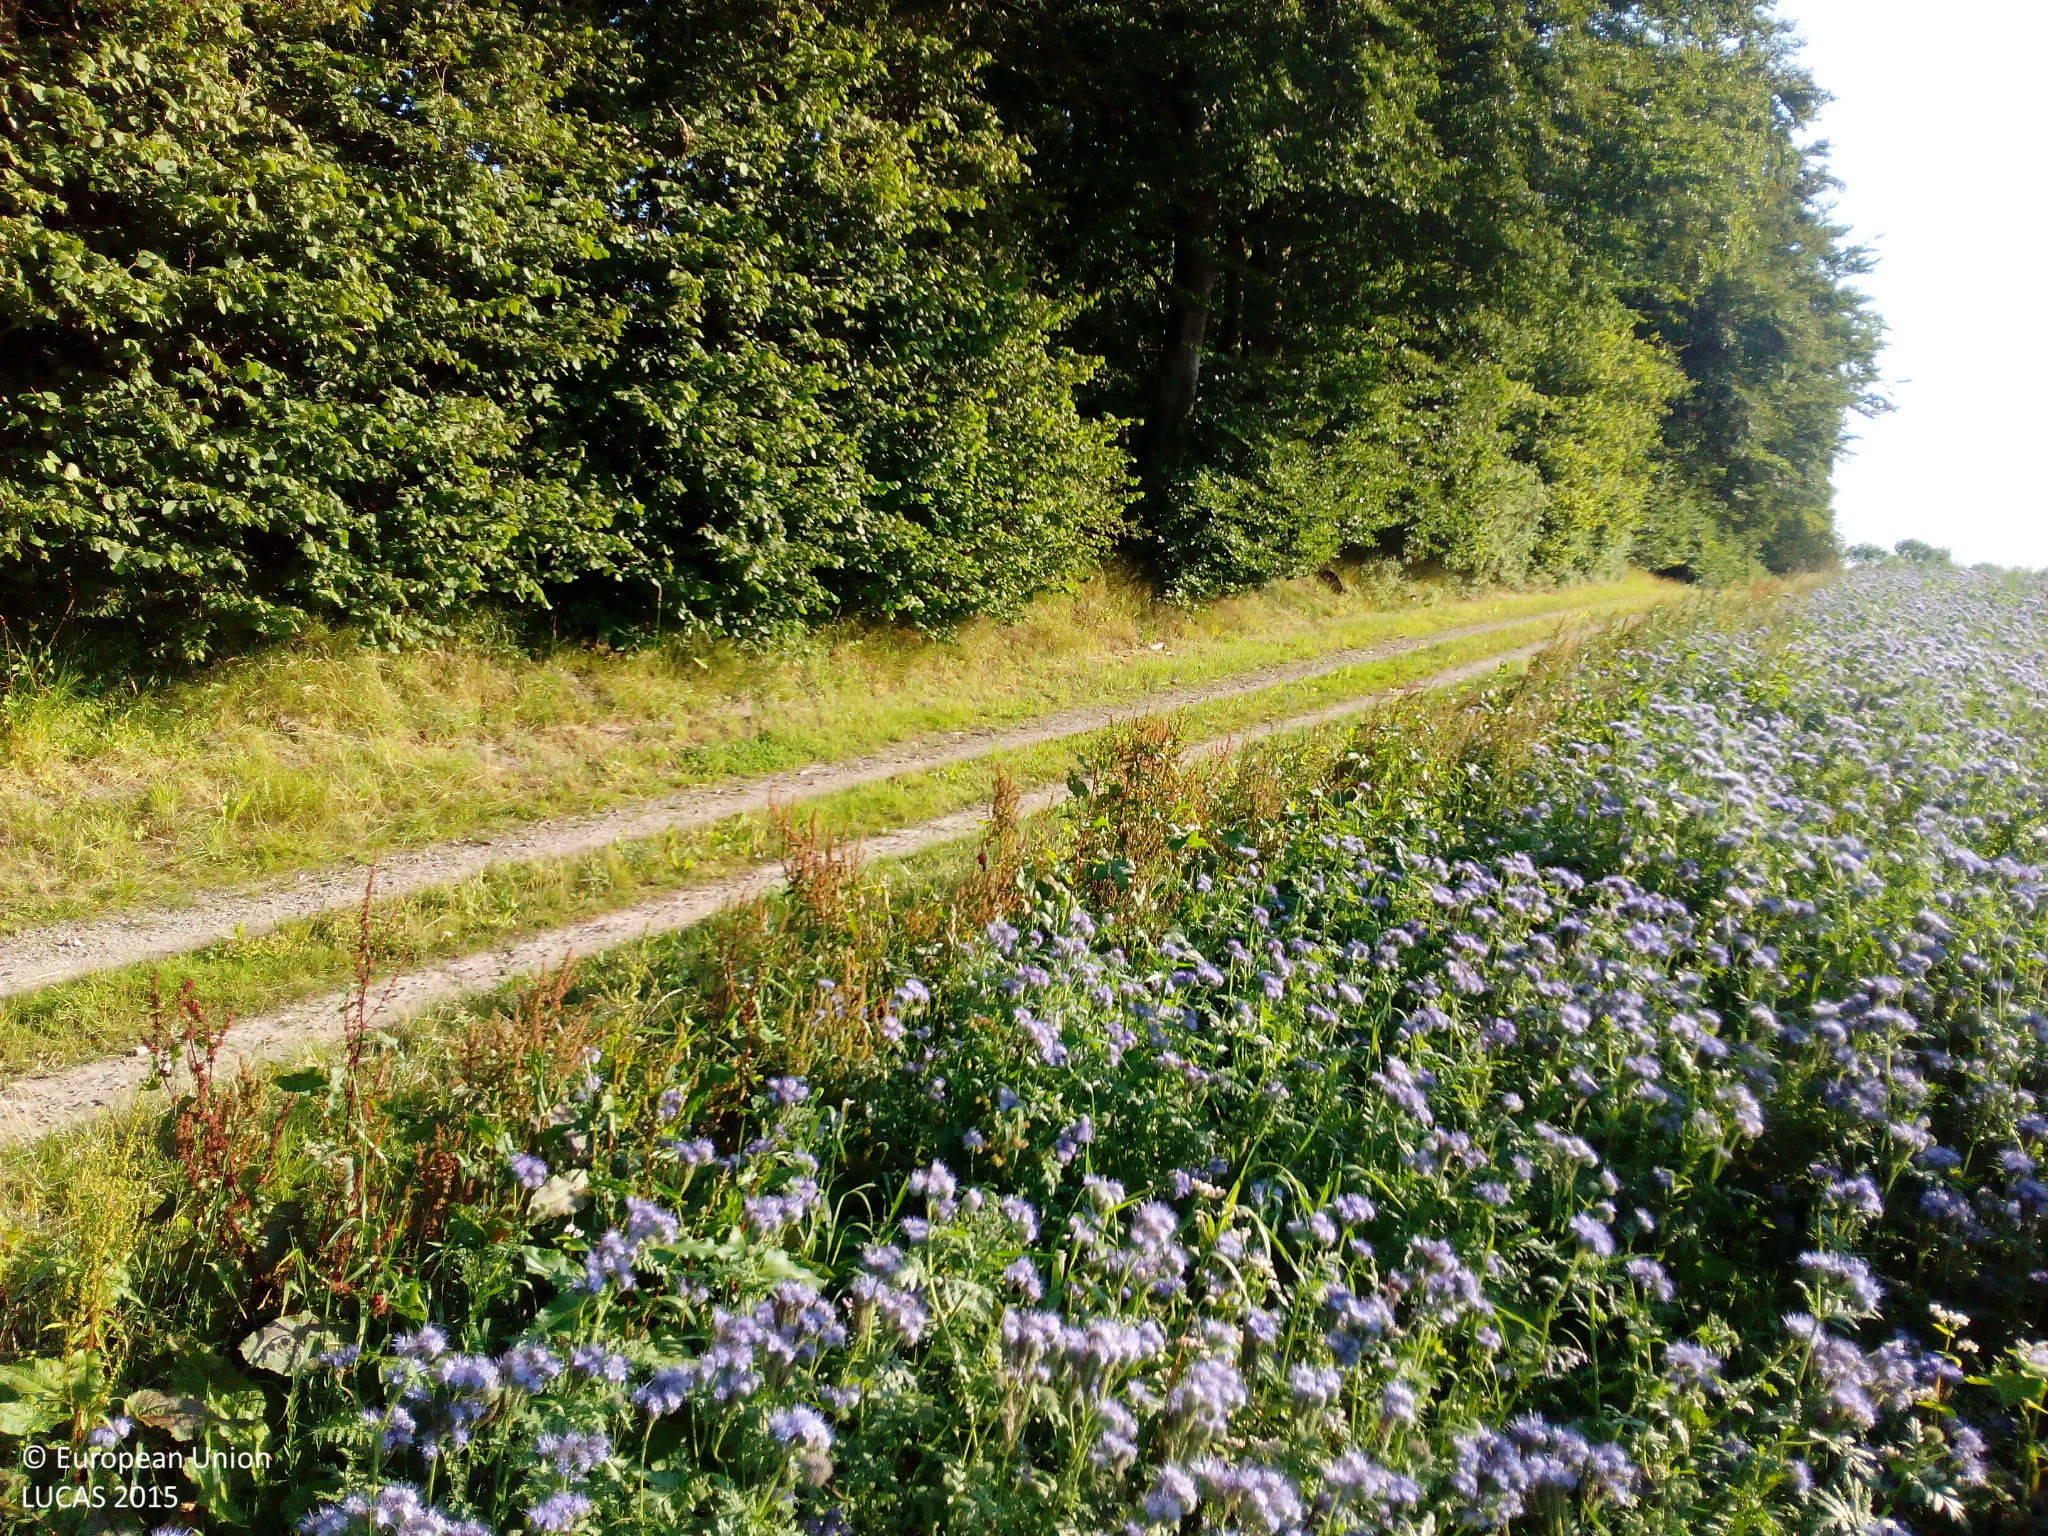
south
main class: Cropland
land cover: Lucerne
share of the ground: > 75 %
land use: Agriculture (excluding fallow land and kitchen gardens)
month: August
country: DK
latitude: 55.6709
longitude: 11.8586
